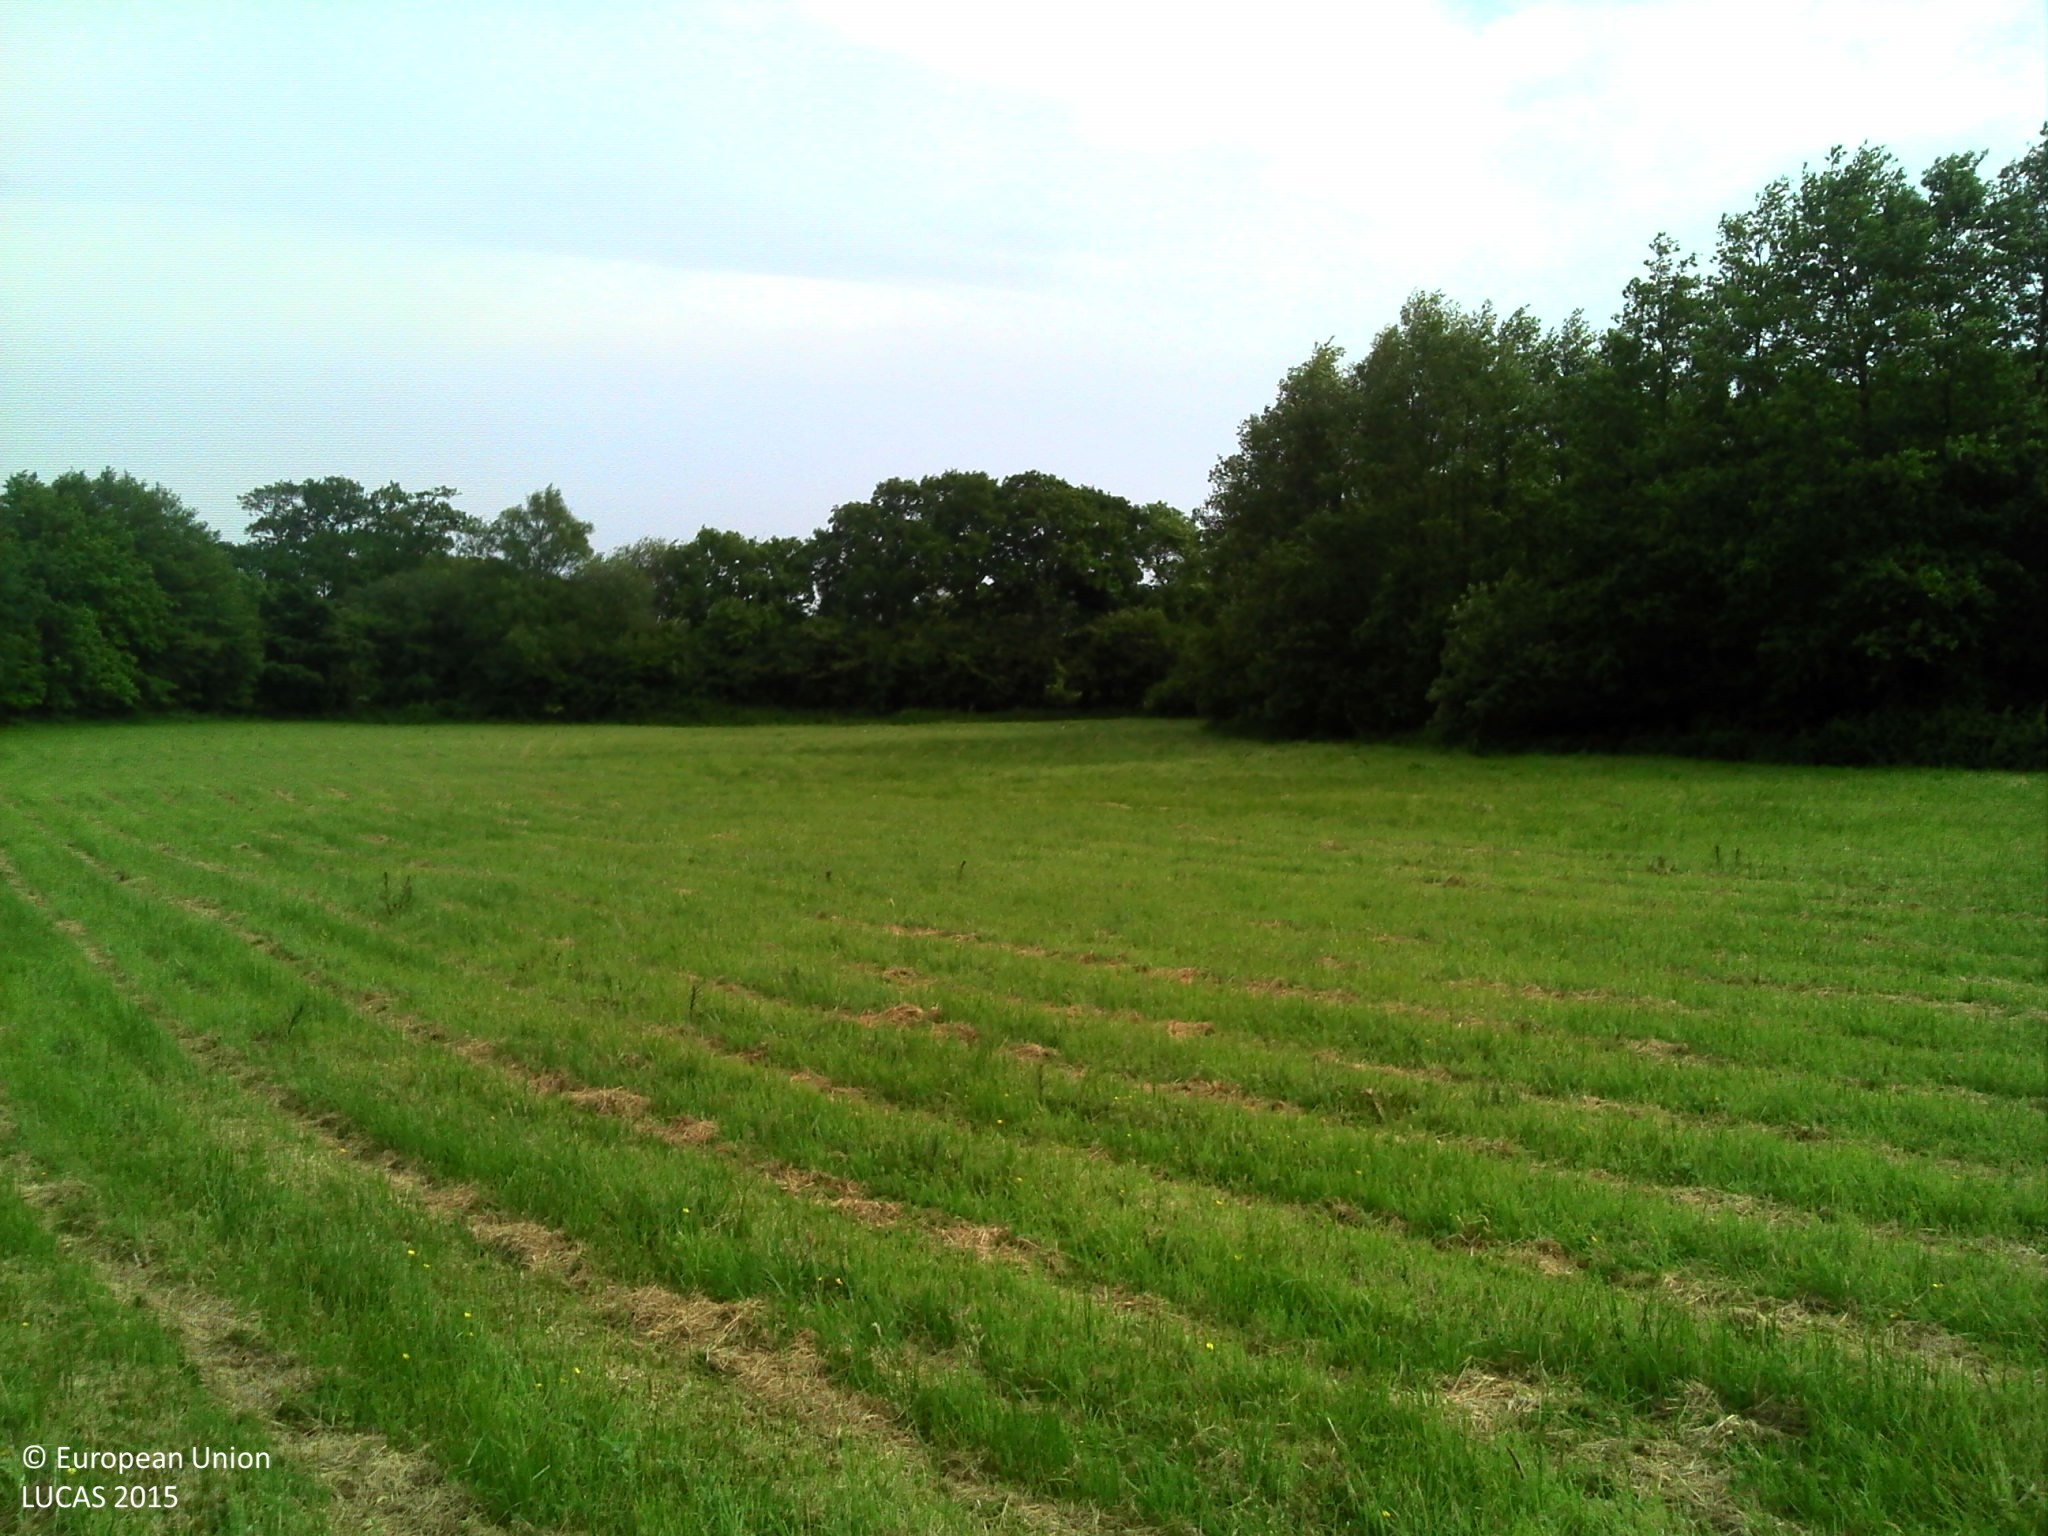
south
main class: Grassland
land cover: Grassland without tree/shrub cover
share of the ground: > 75 %
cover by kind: herbaceous plants 100 %
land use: Agriculture (excluding fallow land and kitchen gardens)
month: June
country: FR
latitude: 49.5001
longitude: -1.4122
